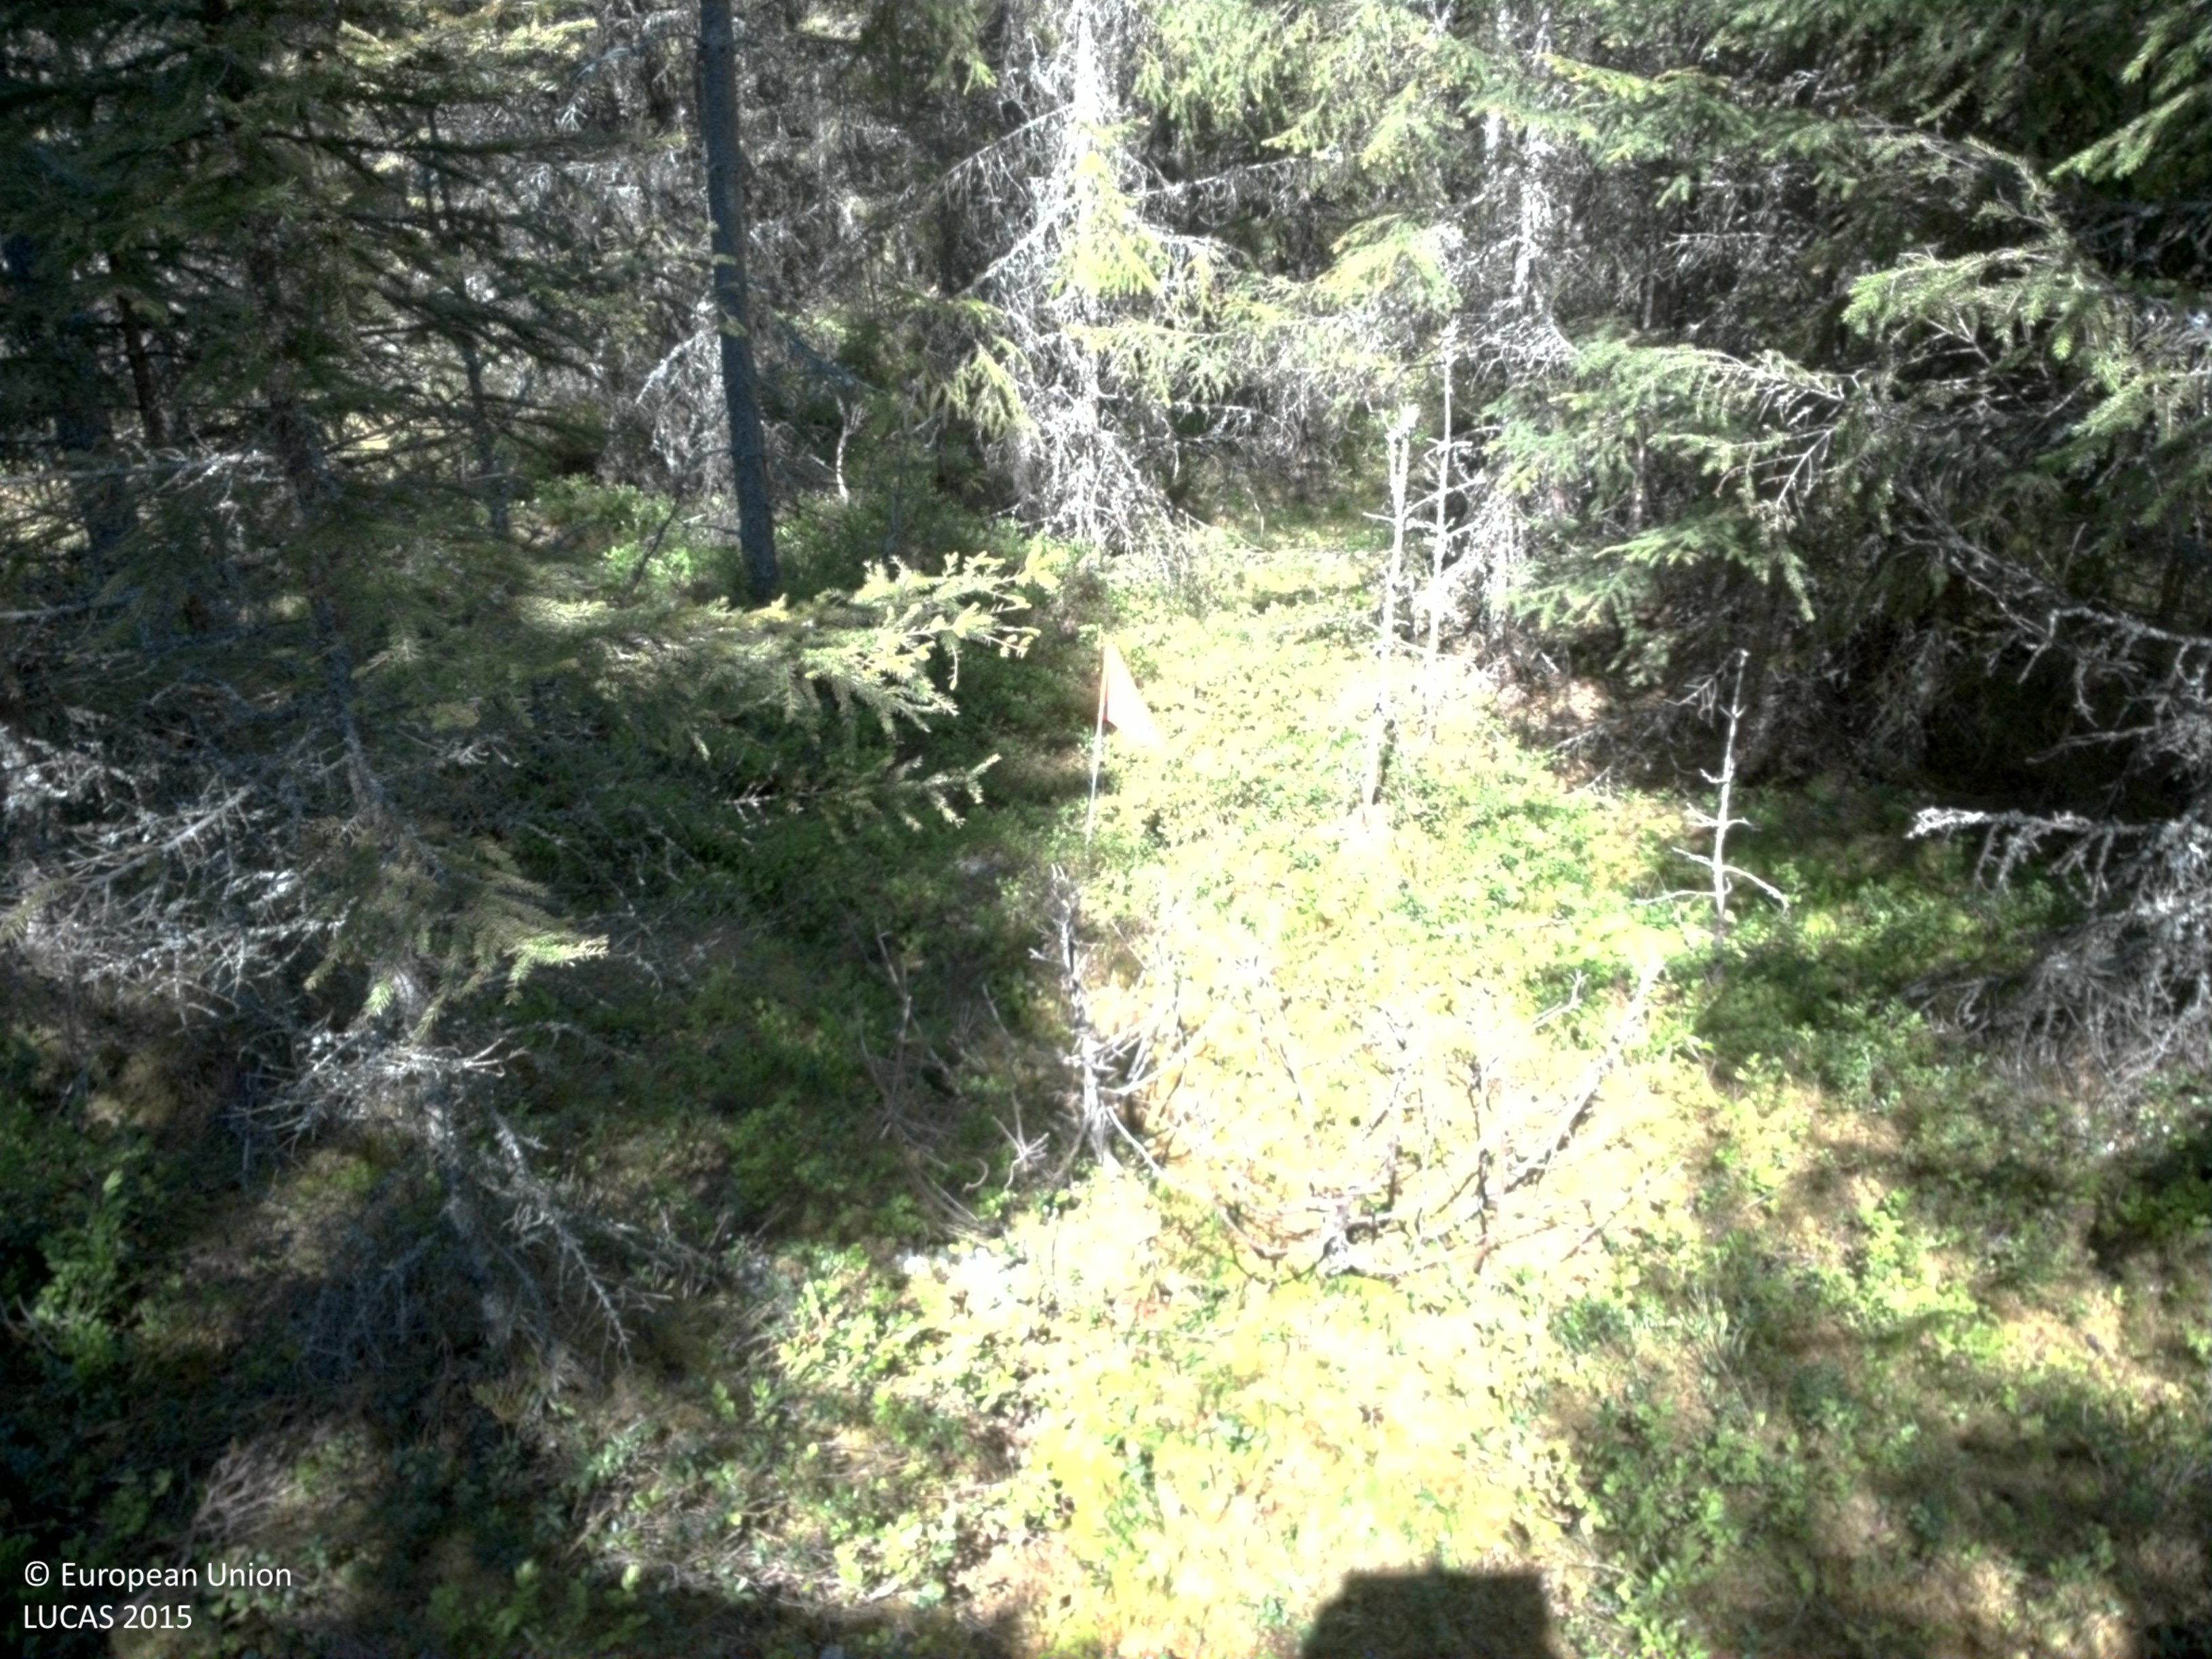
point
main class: Woodland
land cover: Spruce dominated coniferous woodland
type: boreal forest
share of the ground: 50 - 75 %
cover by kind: coniferous forest trees 65 %, shrubs 25 %, broadleaved forest trees 5 %, lichens and mosses 5 %
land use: Forestry
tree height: > 5 m
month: June
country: SE
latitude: 60.4325
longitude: 13.2062
